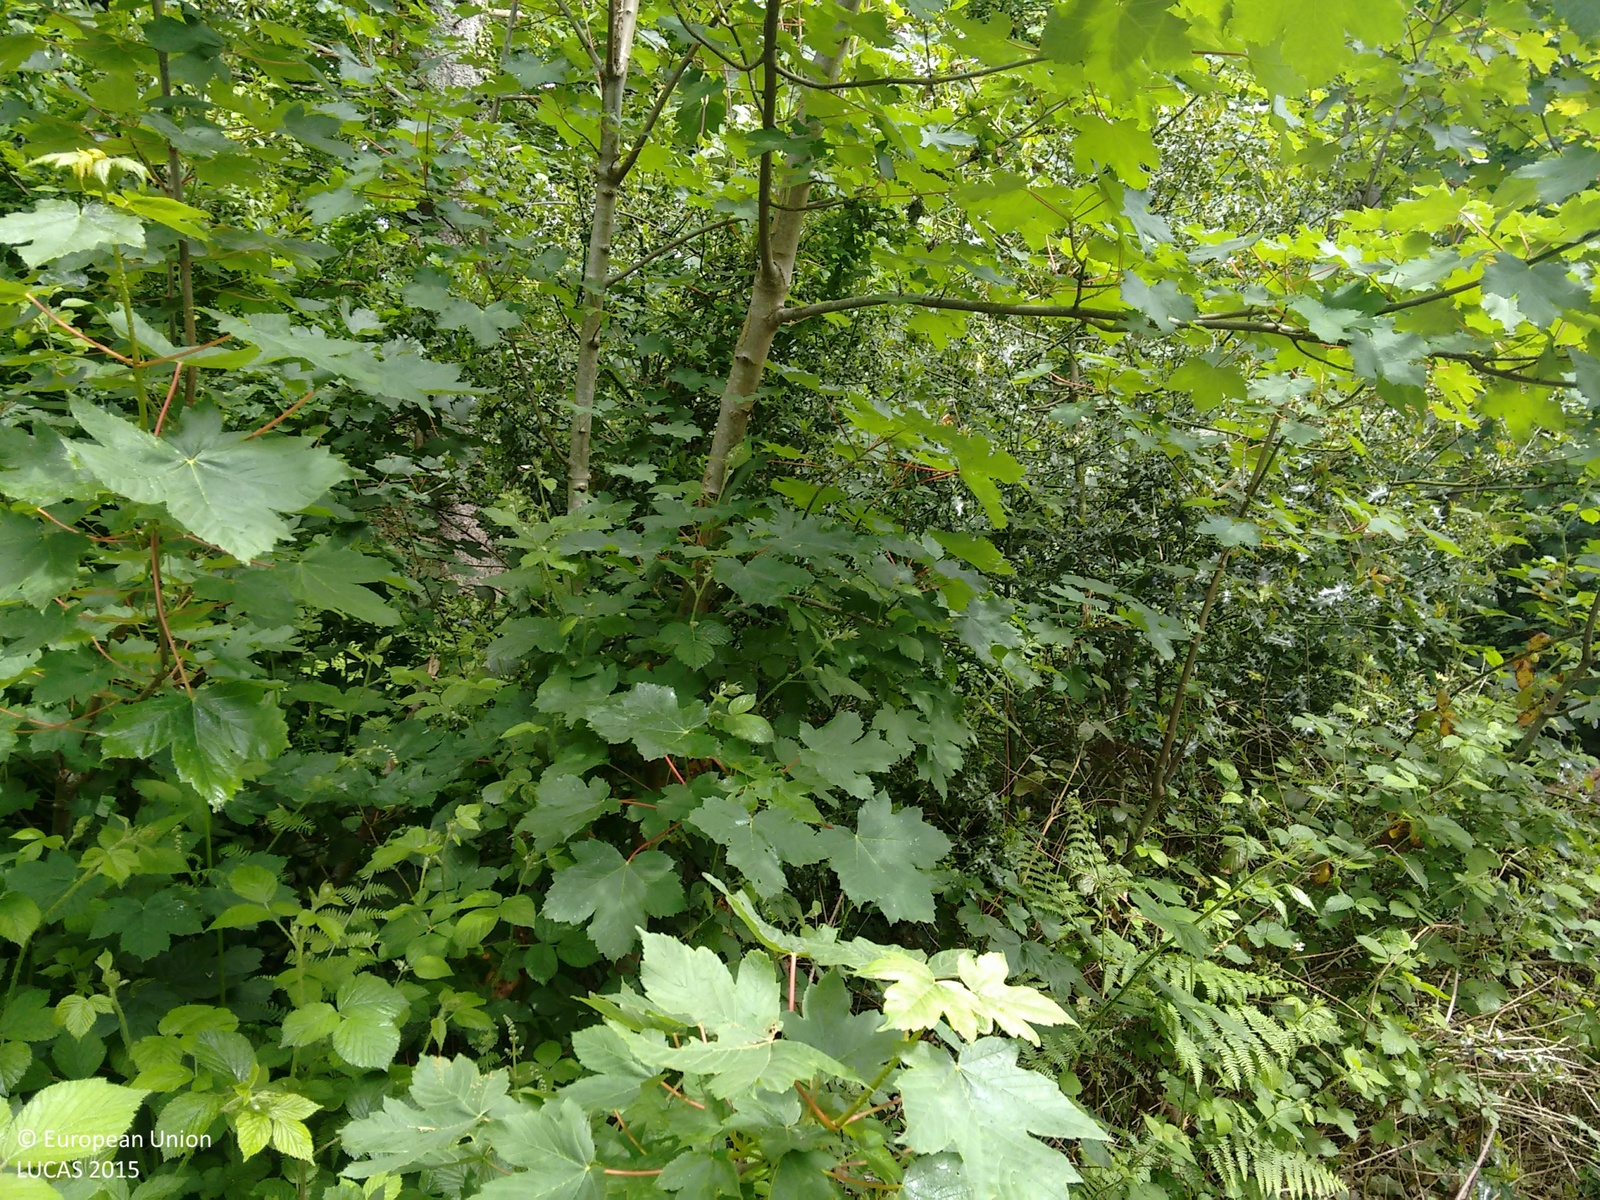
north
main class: Woodland
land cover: Broadleaved woodland
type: mesophytic deciduous forest
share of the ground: > 75 %
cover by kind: broadleaved forest trees 90 %, coniferous forest trees 10 %
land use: Forestry
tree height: > 5 m
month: May
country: GB
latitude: 50.8718
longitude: -0.9430
